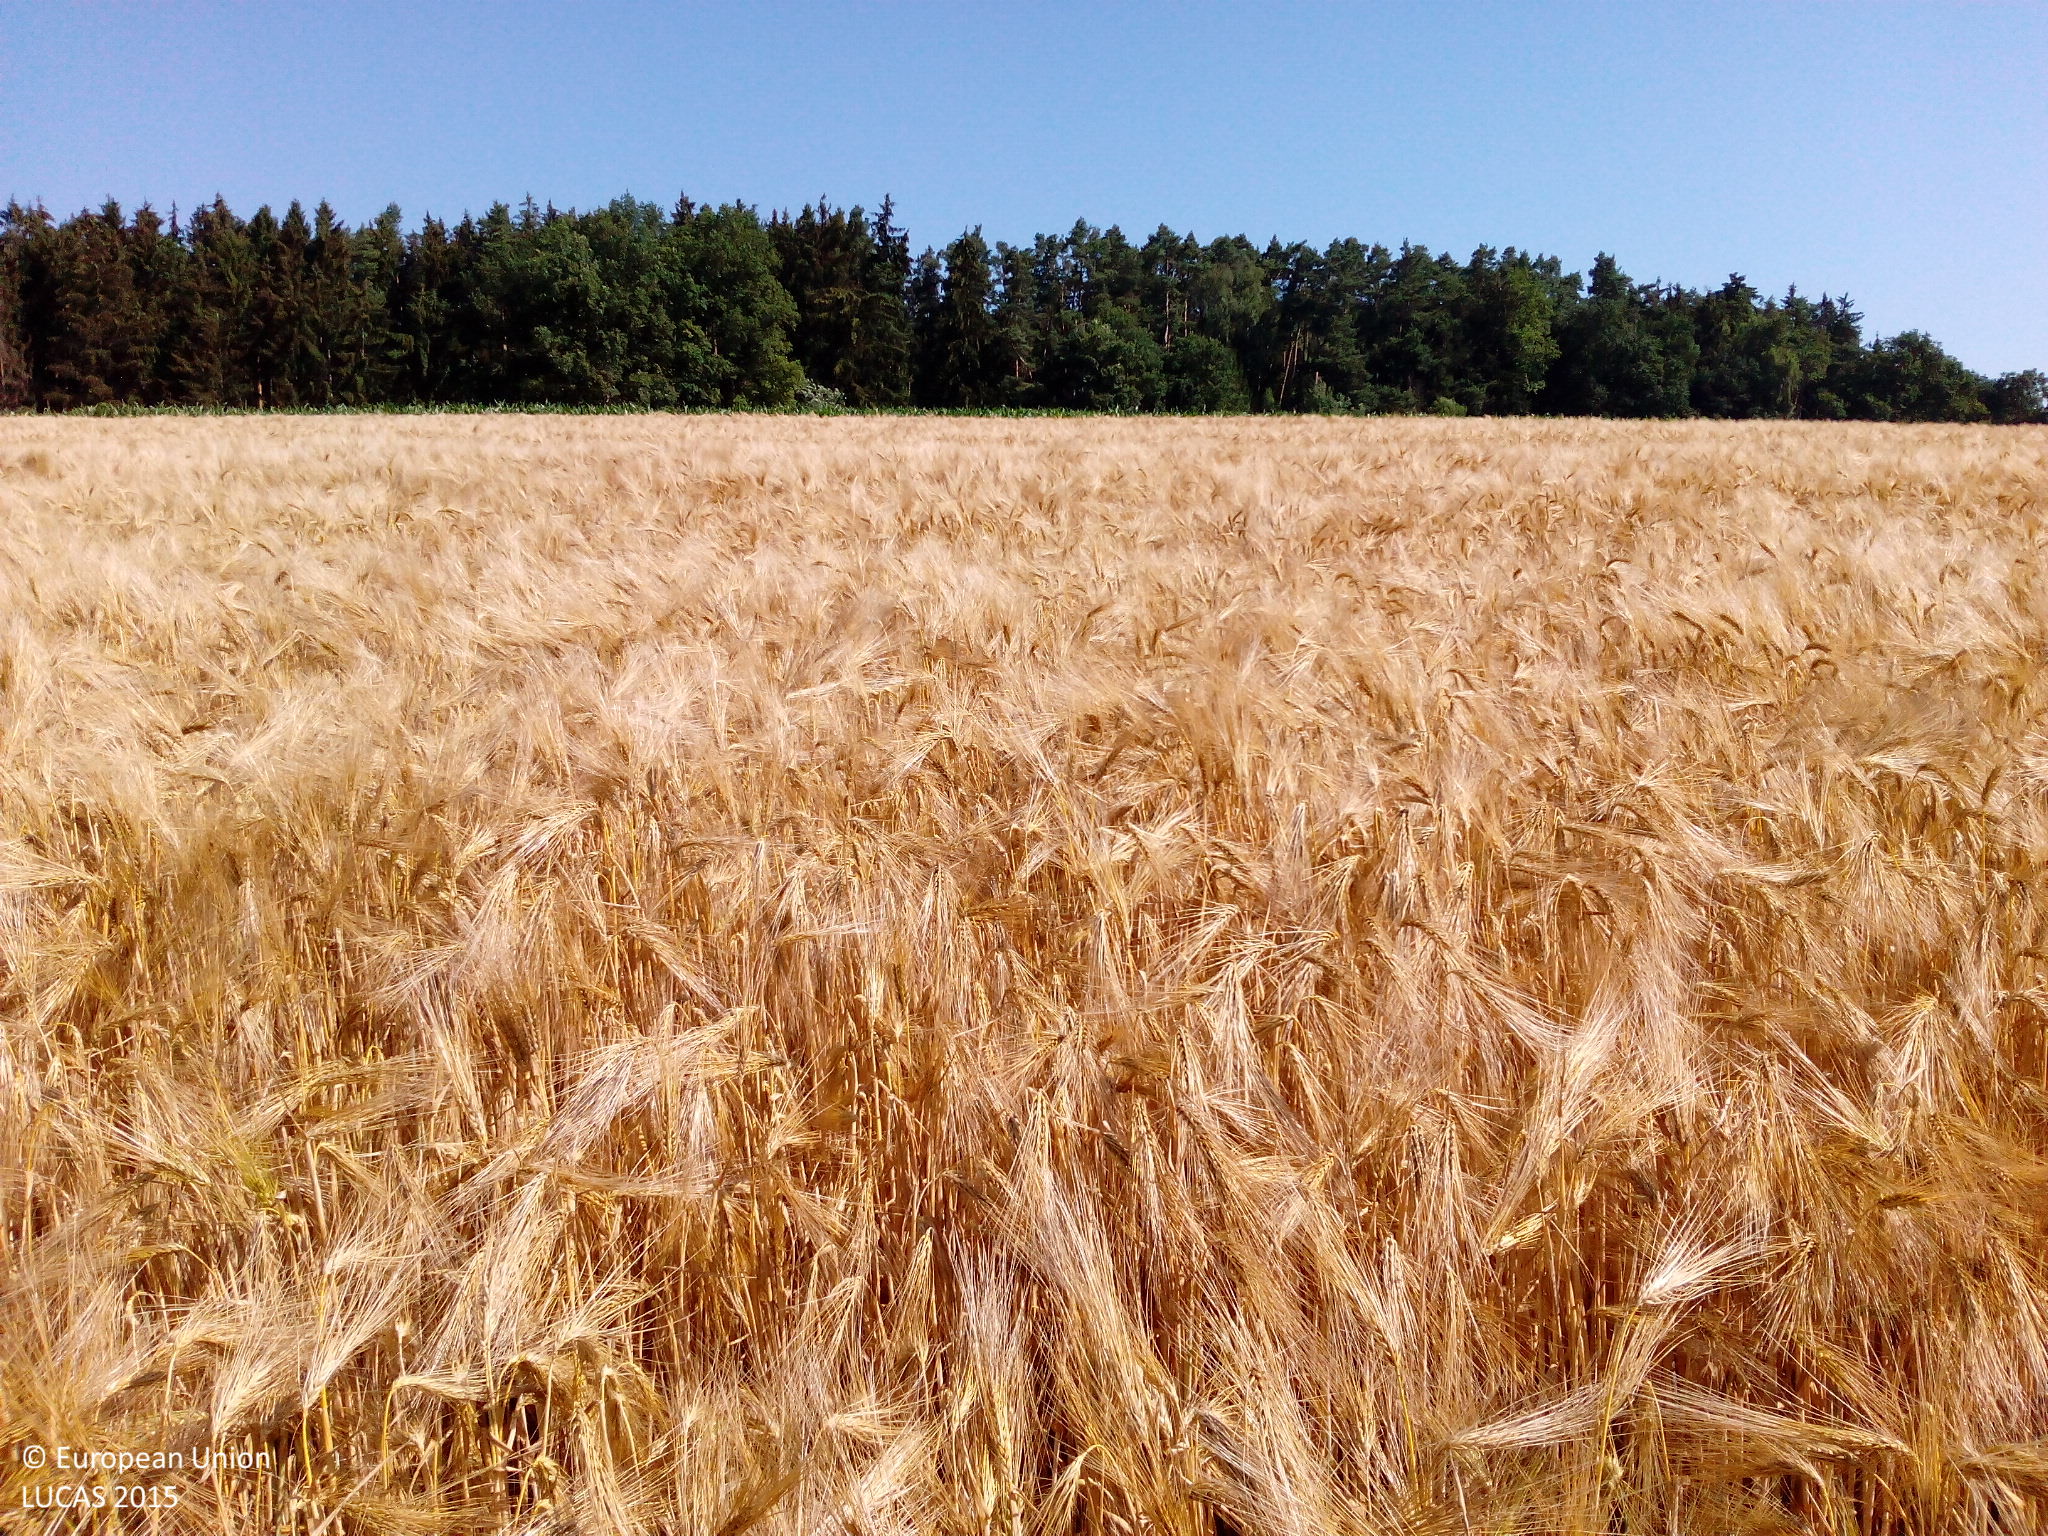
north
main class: Cropland
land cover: Barley
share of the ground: > 75 %
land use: Agriculture (excluding fallow land and kitchen gardens)
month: July
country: DE
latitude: 48.7958
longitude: 10.8844
